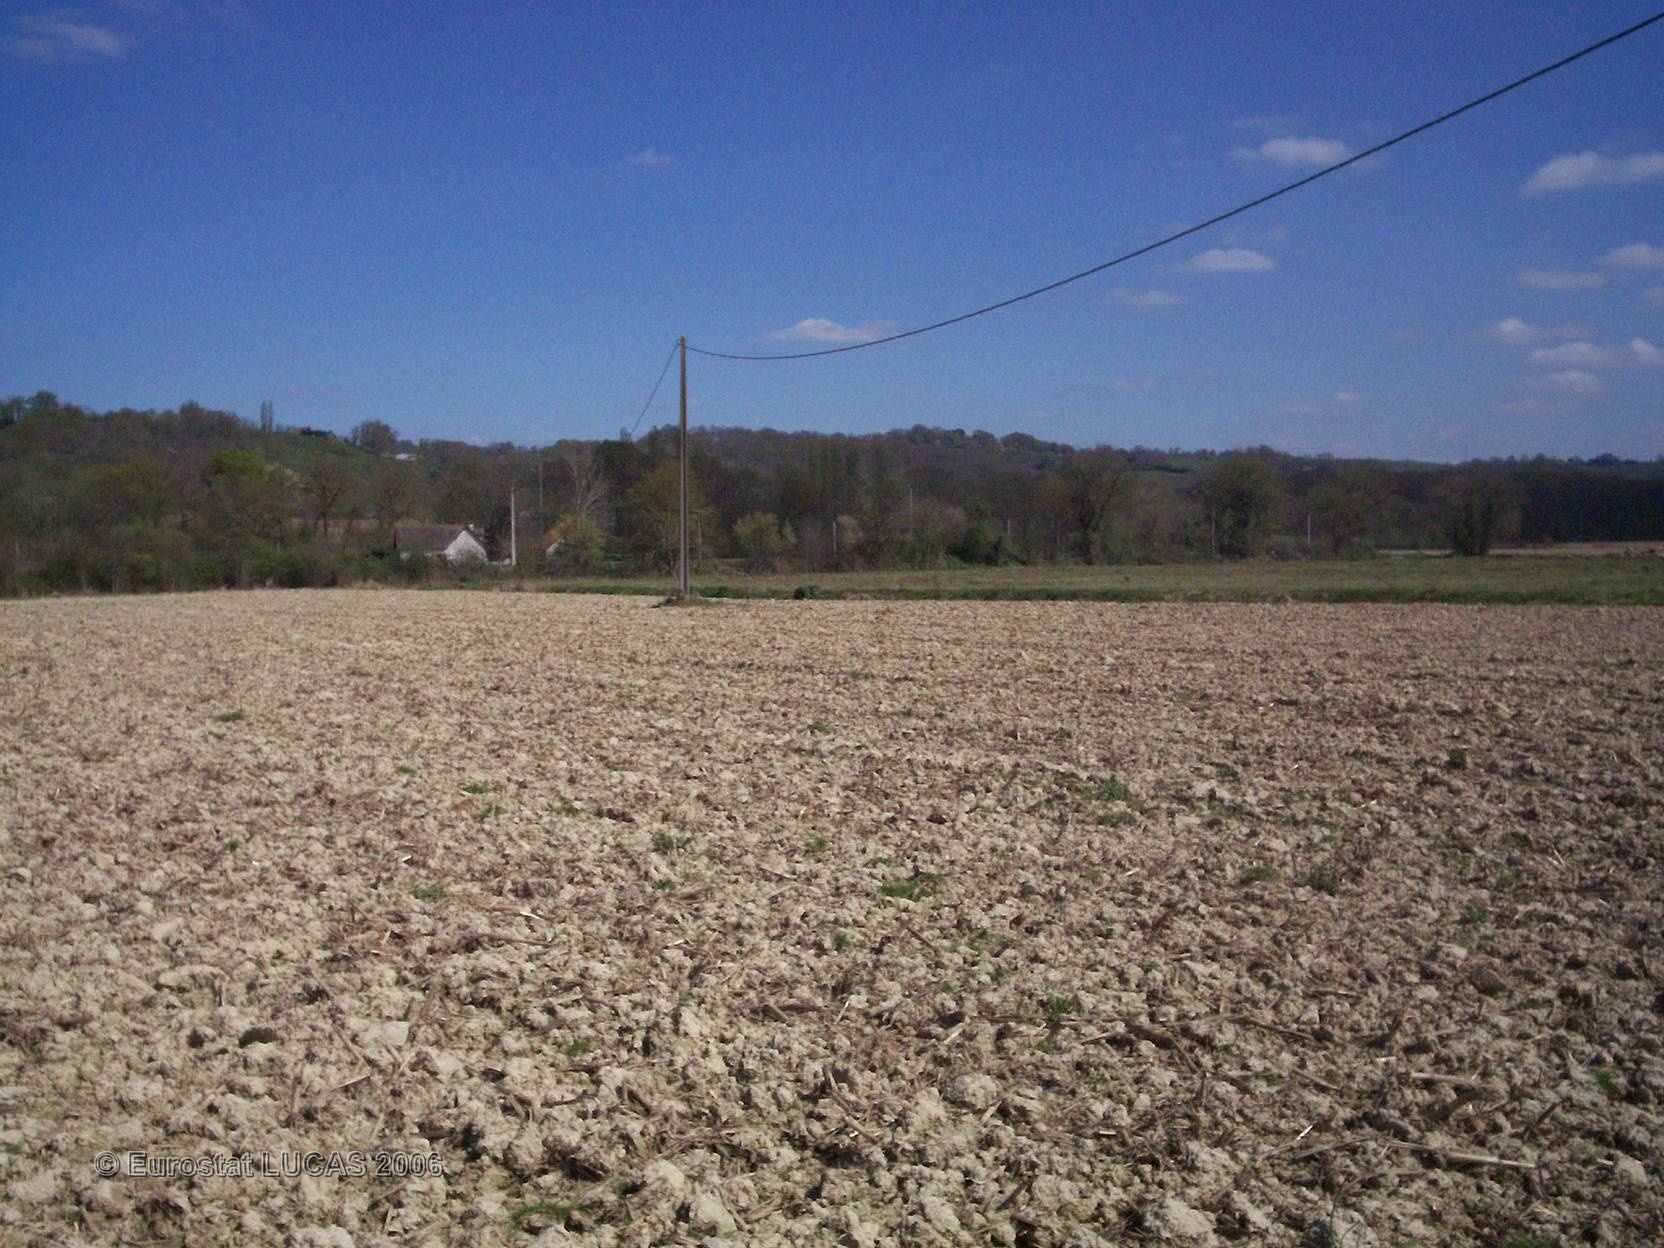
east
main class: Cropland
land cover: Maize
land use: Agriculture (excluding fallow land and kitchen gardens)
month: June
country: FR
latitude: 43.5238
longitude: -0.3390
